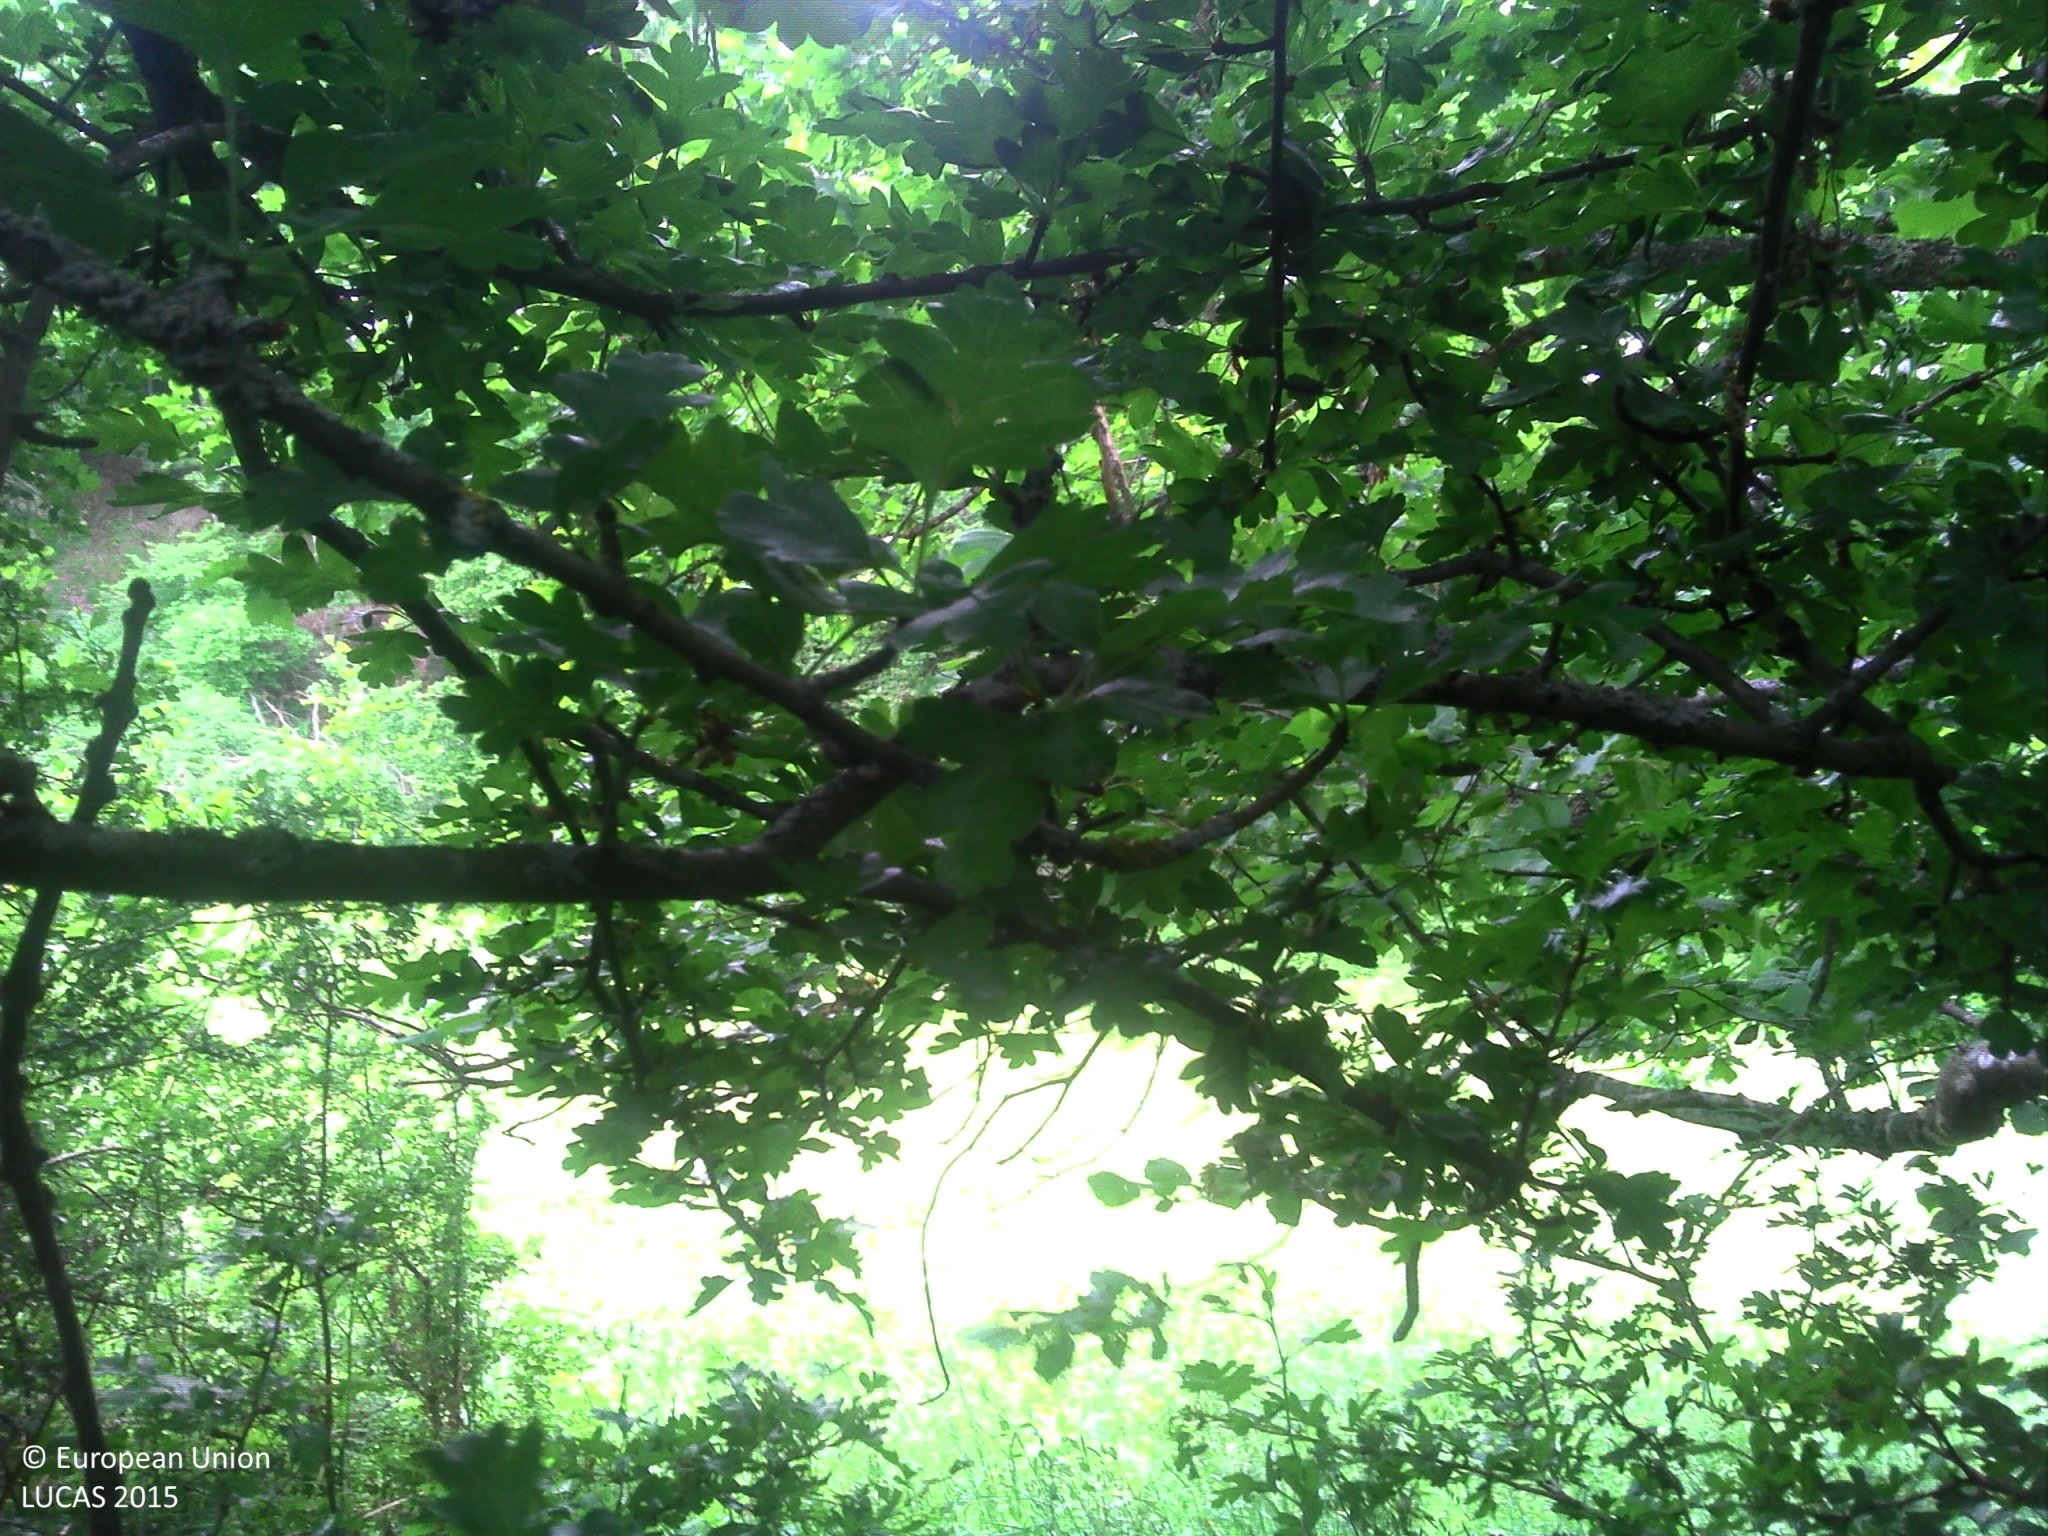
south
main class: Woodland
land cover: Broadleaved woodland
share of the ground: > 75 %
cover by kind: broadleaved forest trees 70 %, herbaceous plants 20 %, shrubs 10 %
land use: Agriculture (excluding fallow land and kitchen gardens)
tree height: > 5 m
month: June
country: FR
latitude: 45.1240
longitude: 3.2261
